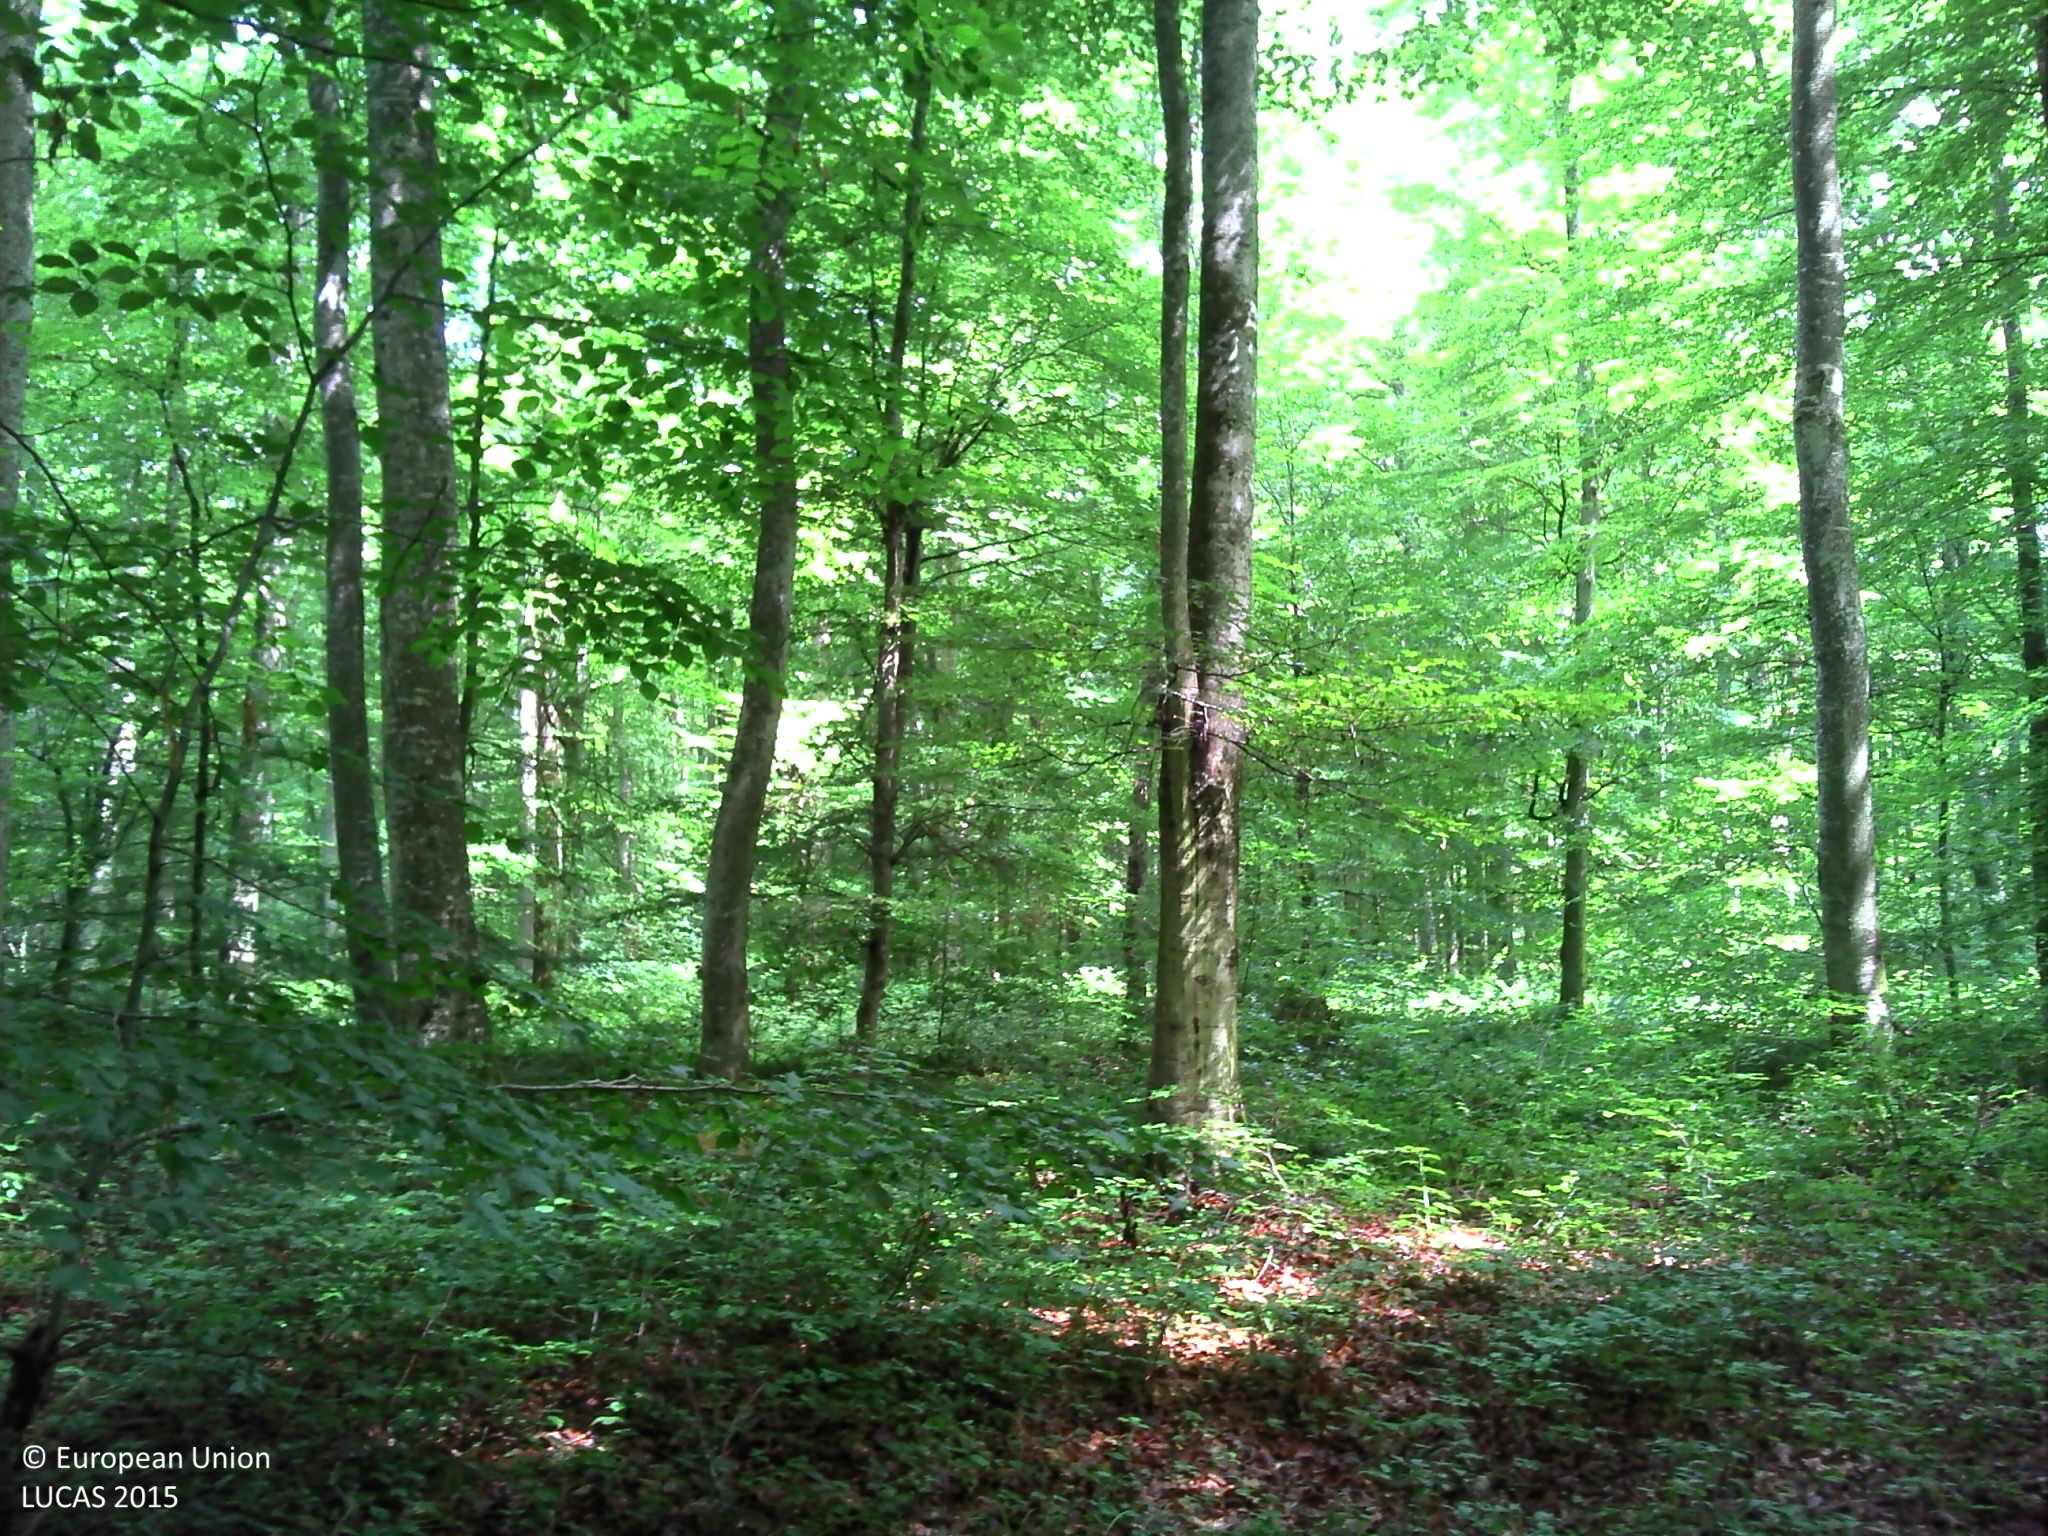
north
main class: Woodland
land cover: Broadleaved woodland
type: beech forest
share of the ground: > 75 %
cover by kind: broadleaved forest trees 90 %, shrubs 5 %, herbaceous plants 5 %
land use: Forestry
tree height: > 5 m
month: June
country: FR
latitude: 46.2129
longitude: 3.0114
